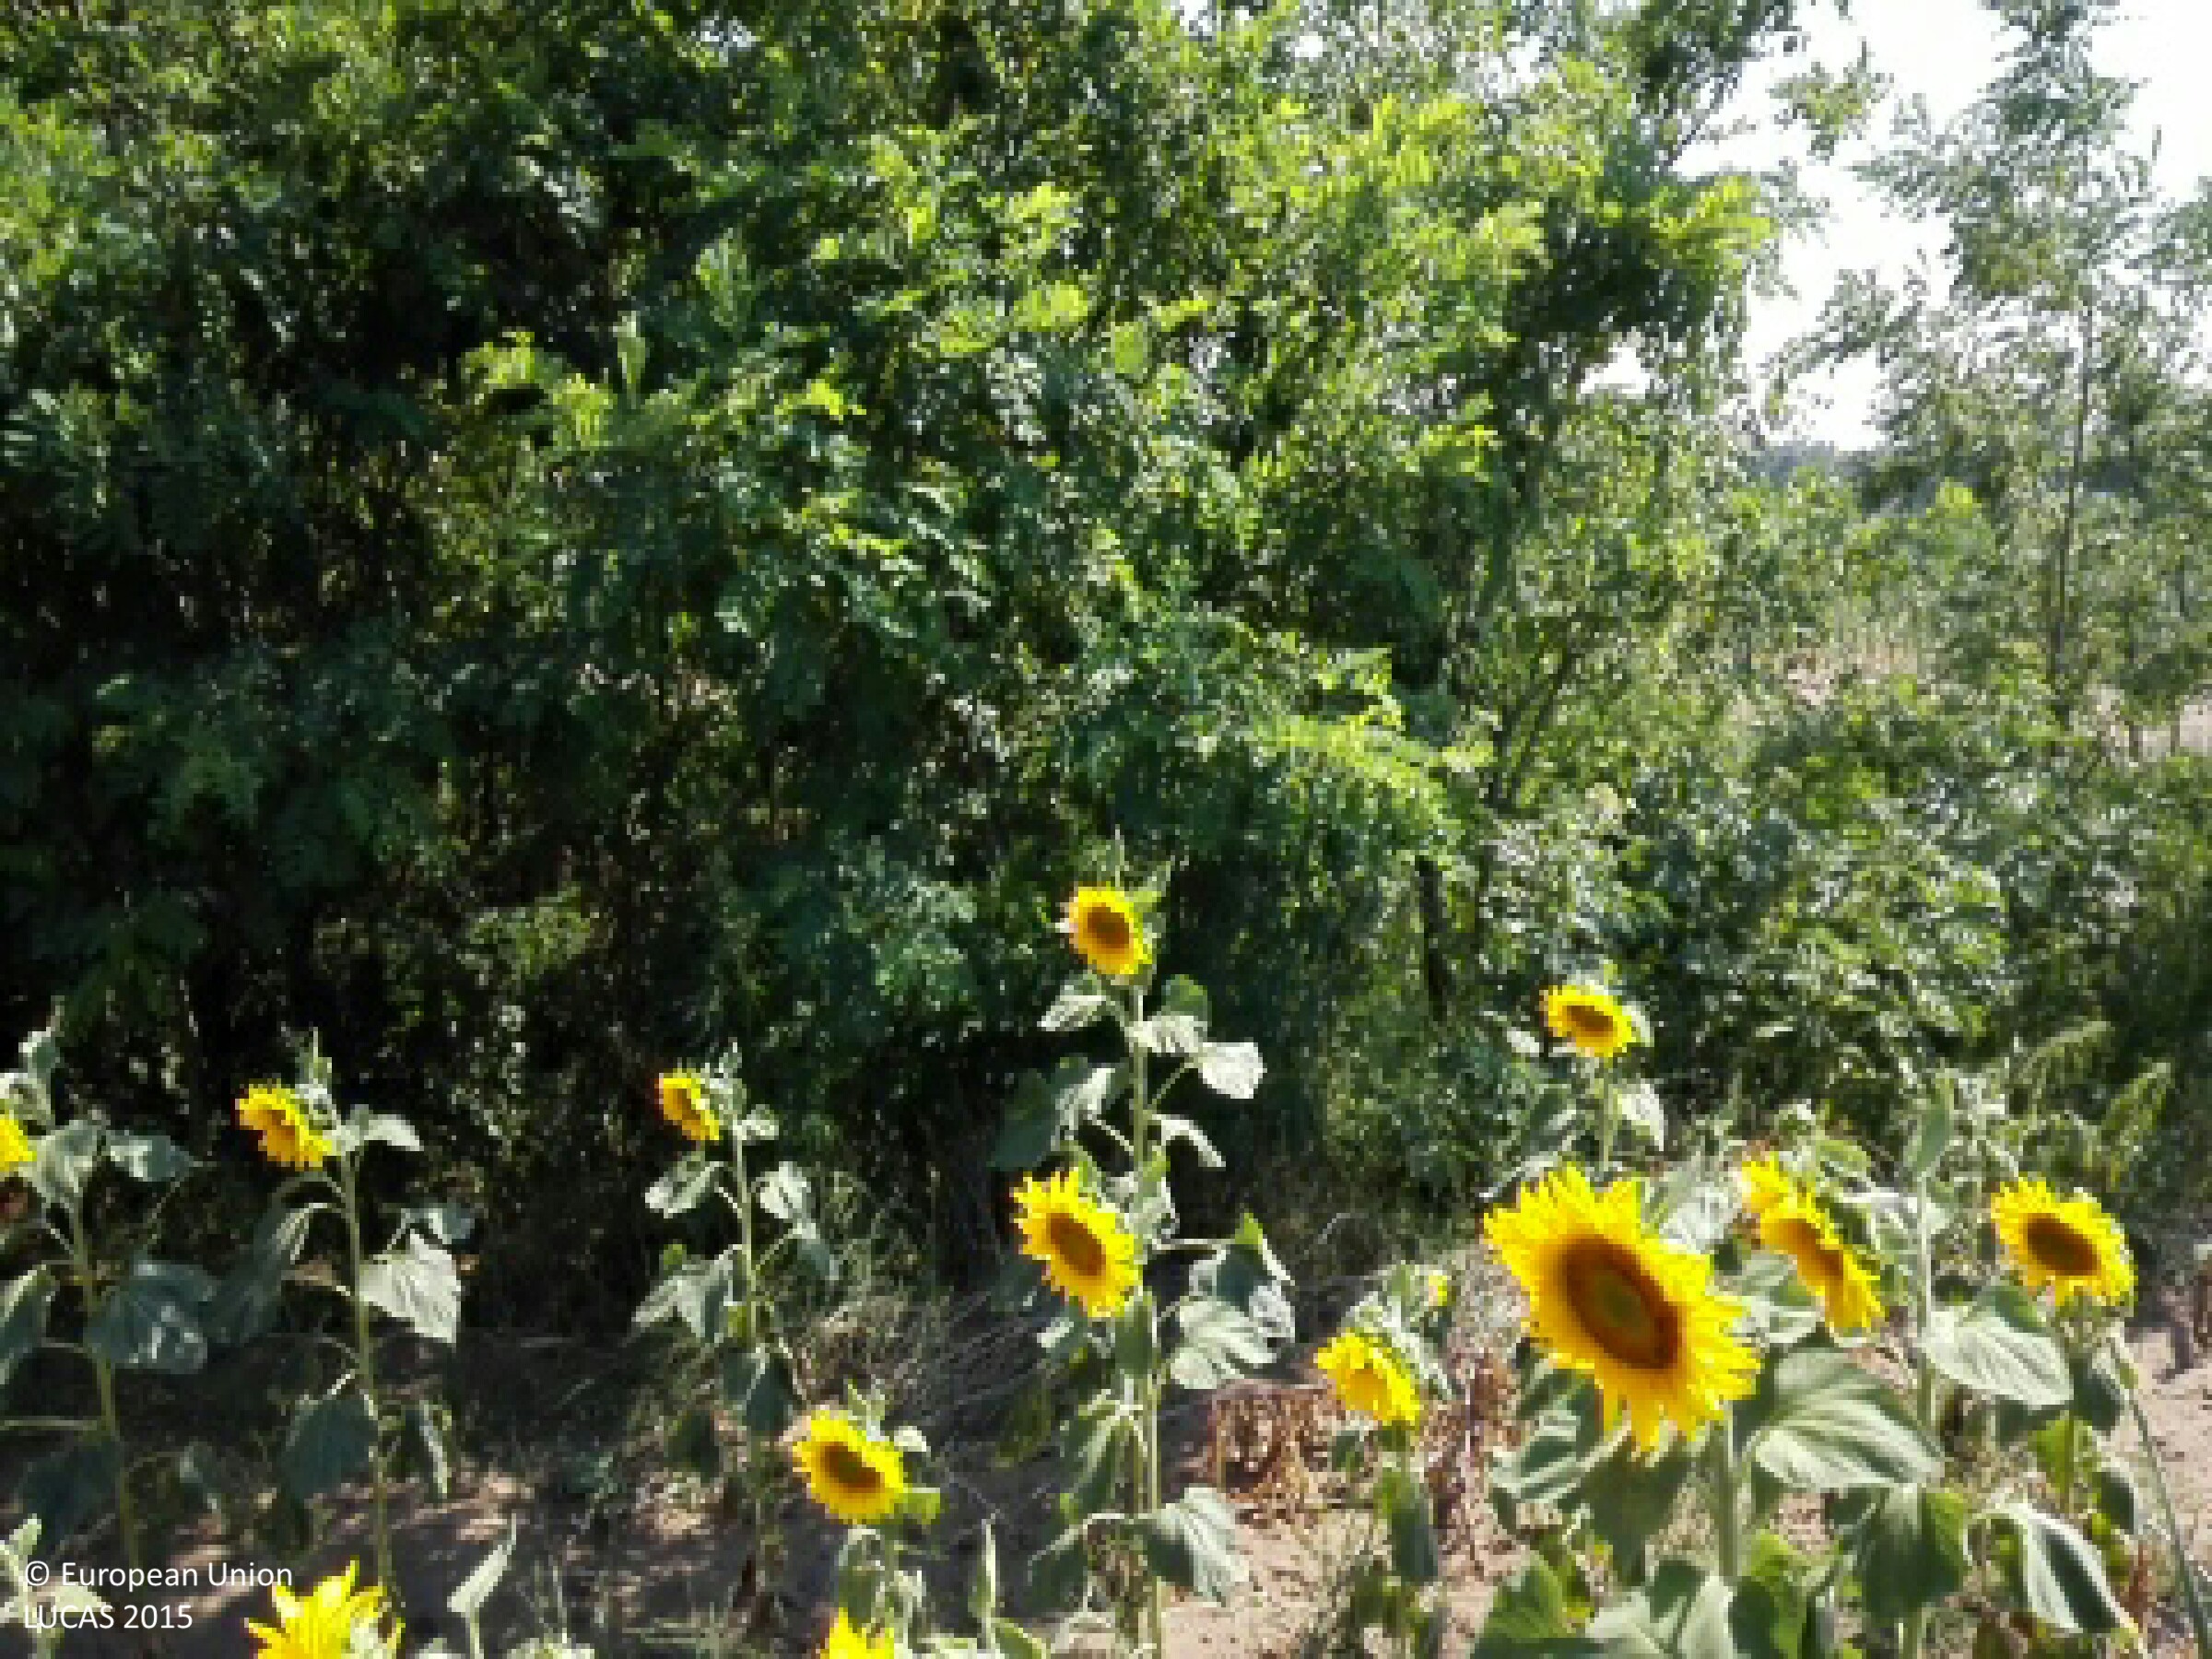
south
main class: Cropland
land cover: Sunflower
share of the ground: 10 - 25 %
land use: Agriculture (excluding fallow land and kitchen gardens)
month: July
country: HU
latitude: 47.6354
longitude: 21.6917
